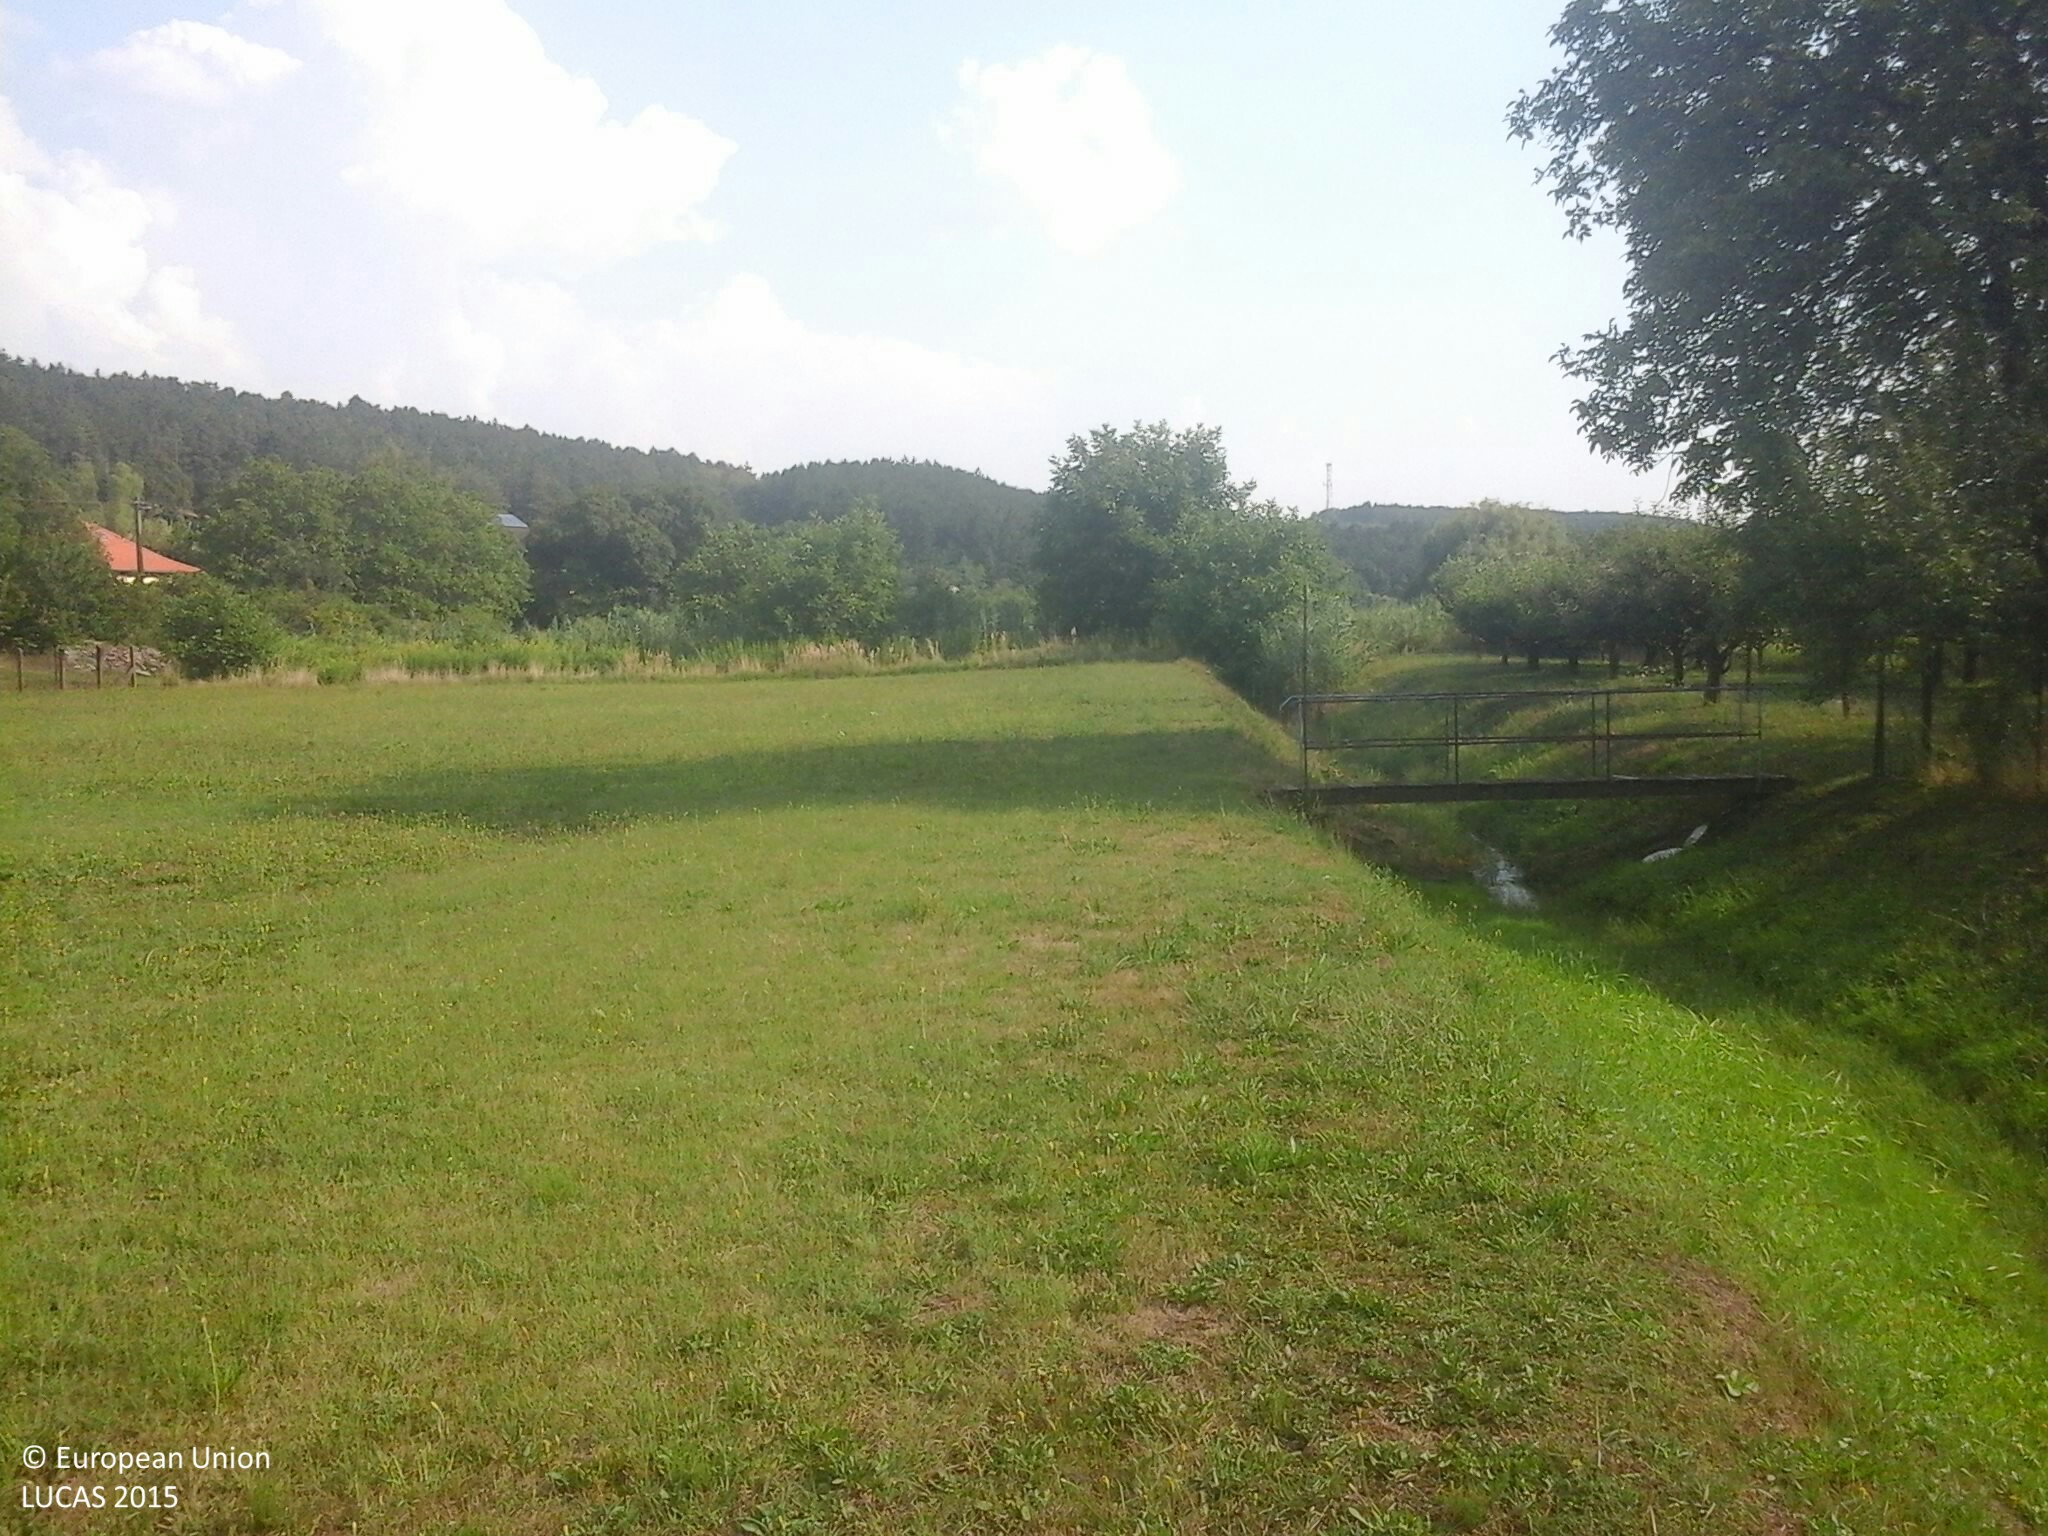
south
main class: Grassland
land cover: Grassland with sparse tree/shrub cover
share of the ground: > 75 %
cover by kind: herbaceous plants 90 %, coniferous forest trees 5 %, shrubs 5 %
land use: Residential
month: August
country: HU
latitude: 46.1344
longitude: 18.3308
